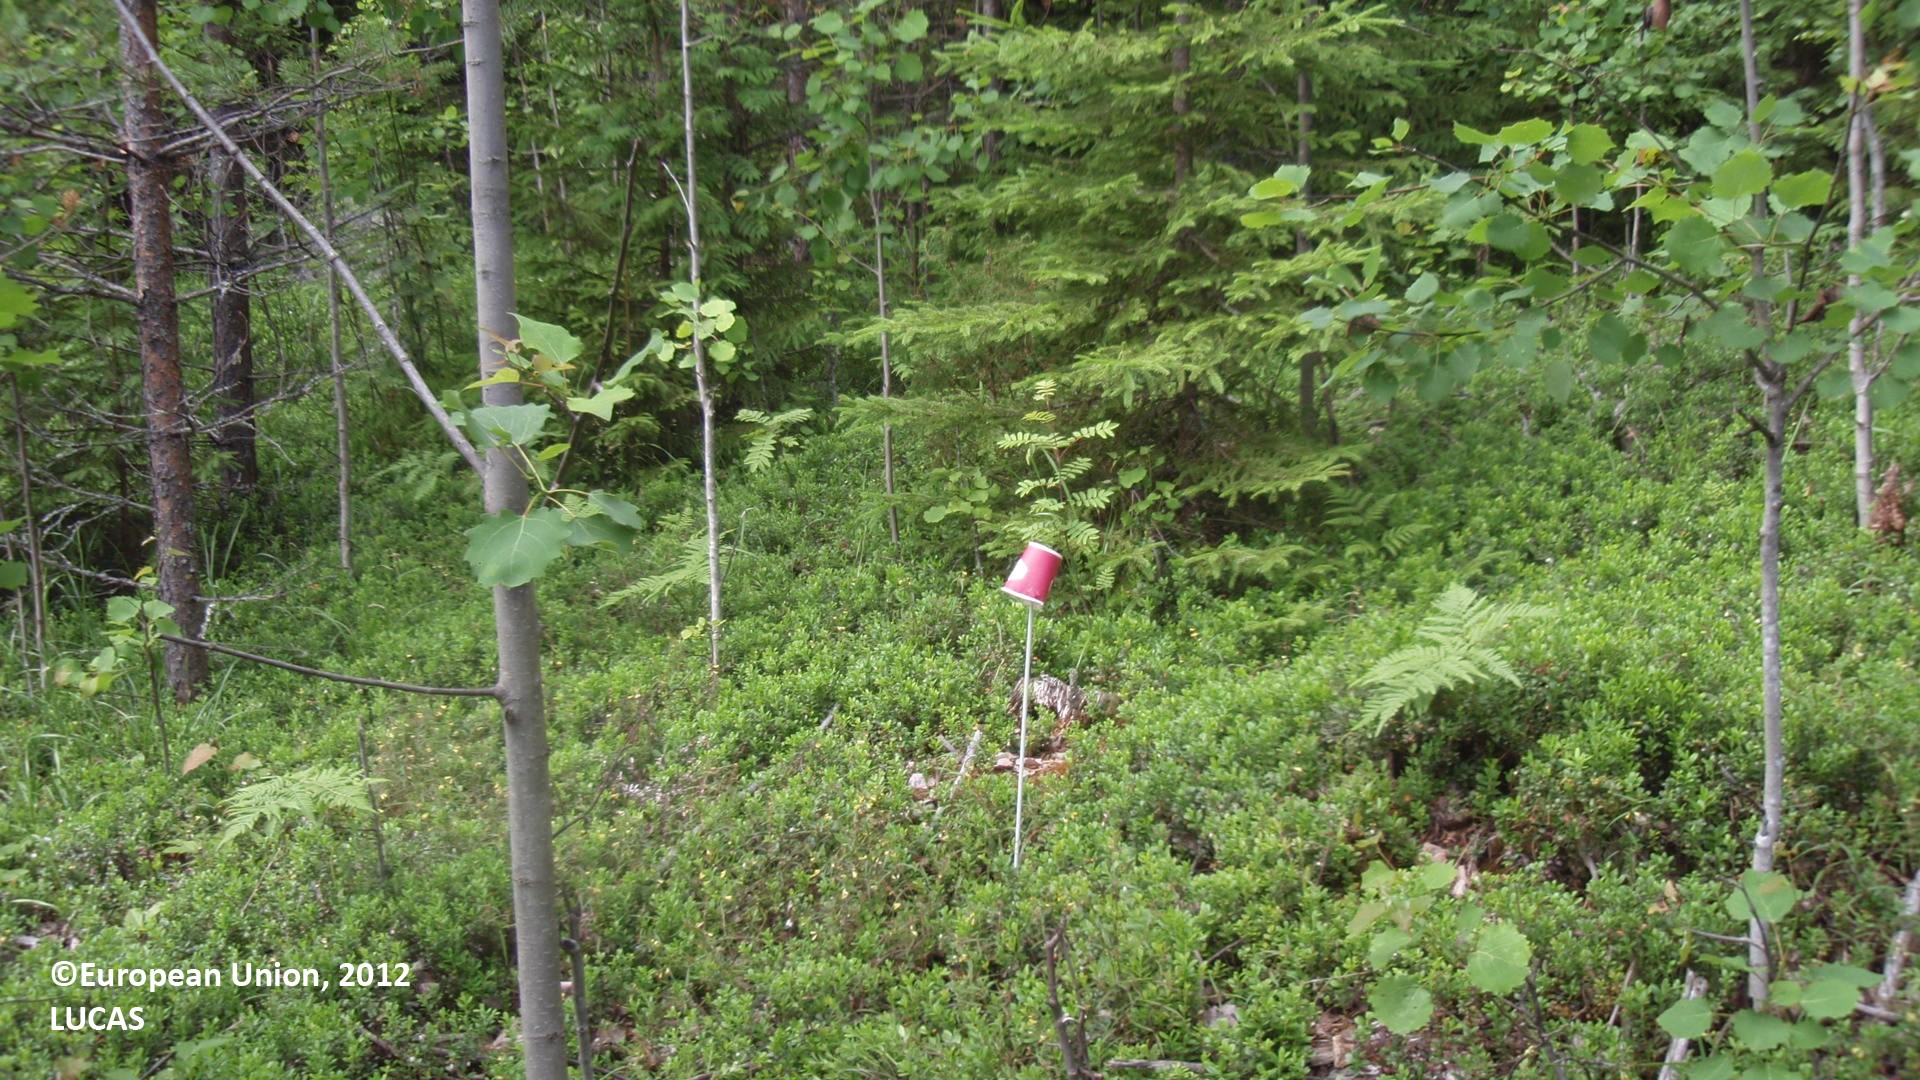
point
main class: Woodland
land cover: Spruce dominated mixed woodland
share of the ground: 25 - 50 %
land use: Forestry
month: July
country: FI
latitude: 61.7039
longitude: 28.1040
